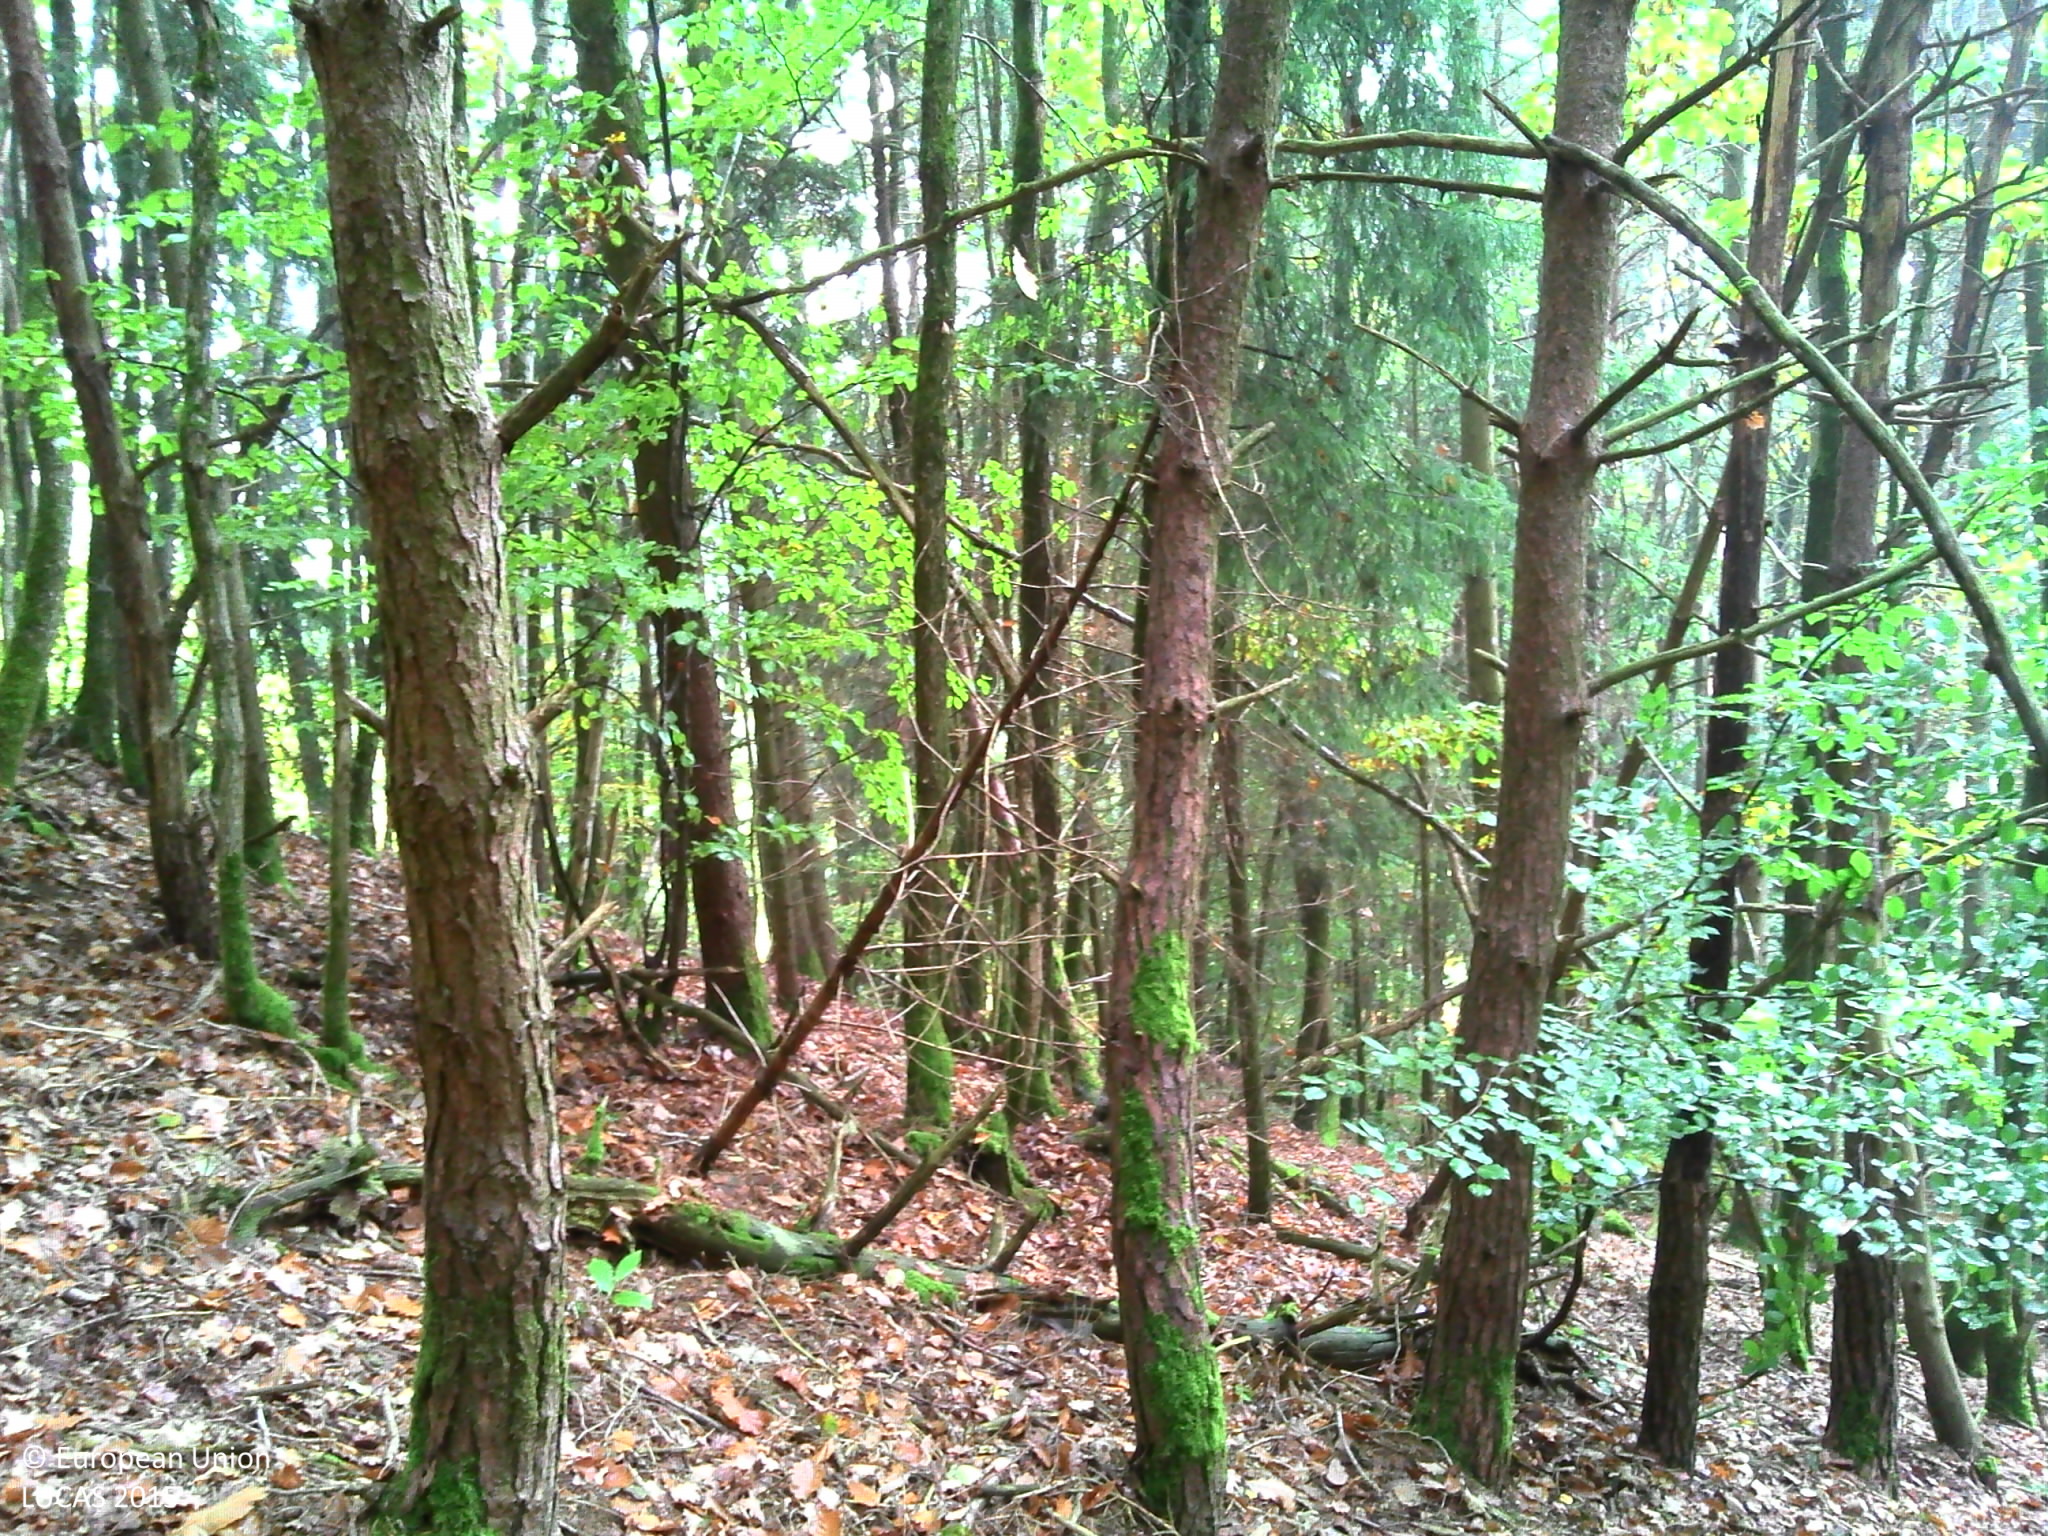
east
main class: Woodland
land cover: Spruce dominated mixed woodland
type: hemiboreal forest and nemoral coniferous forest and mixed broadleaved-coniferous forest
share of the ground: > 75 %
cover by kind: coniferous forest trees 60 %, broadleaved forest trees 25 %, herbaceous plants 15 %
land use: Forestry
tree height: > 5 m
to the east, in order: Spruce dominated mixed woodland; Shrubland with sparse tree cover; Broadleaved woodland; Other coniferous woodland; Spontaneously vegetated surfaces; Ditches and canals; Grass margins; Paved roads, cycling and walking lanes; Spontaneously vegetated surfaces; Fences; Shrubland with sparse tree cover; Grassland without tree/shrub cover; Shrubland with sparse tree cover; Ditches and canals; Shrubland with sparse tree cover; Grassland without tree/shrub cover; Shrubland without tree cover; Grassland without tree/shrub cover; Shrubland without tree cover
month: October
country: FR
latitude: 46.1437
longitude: 2.7865
